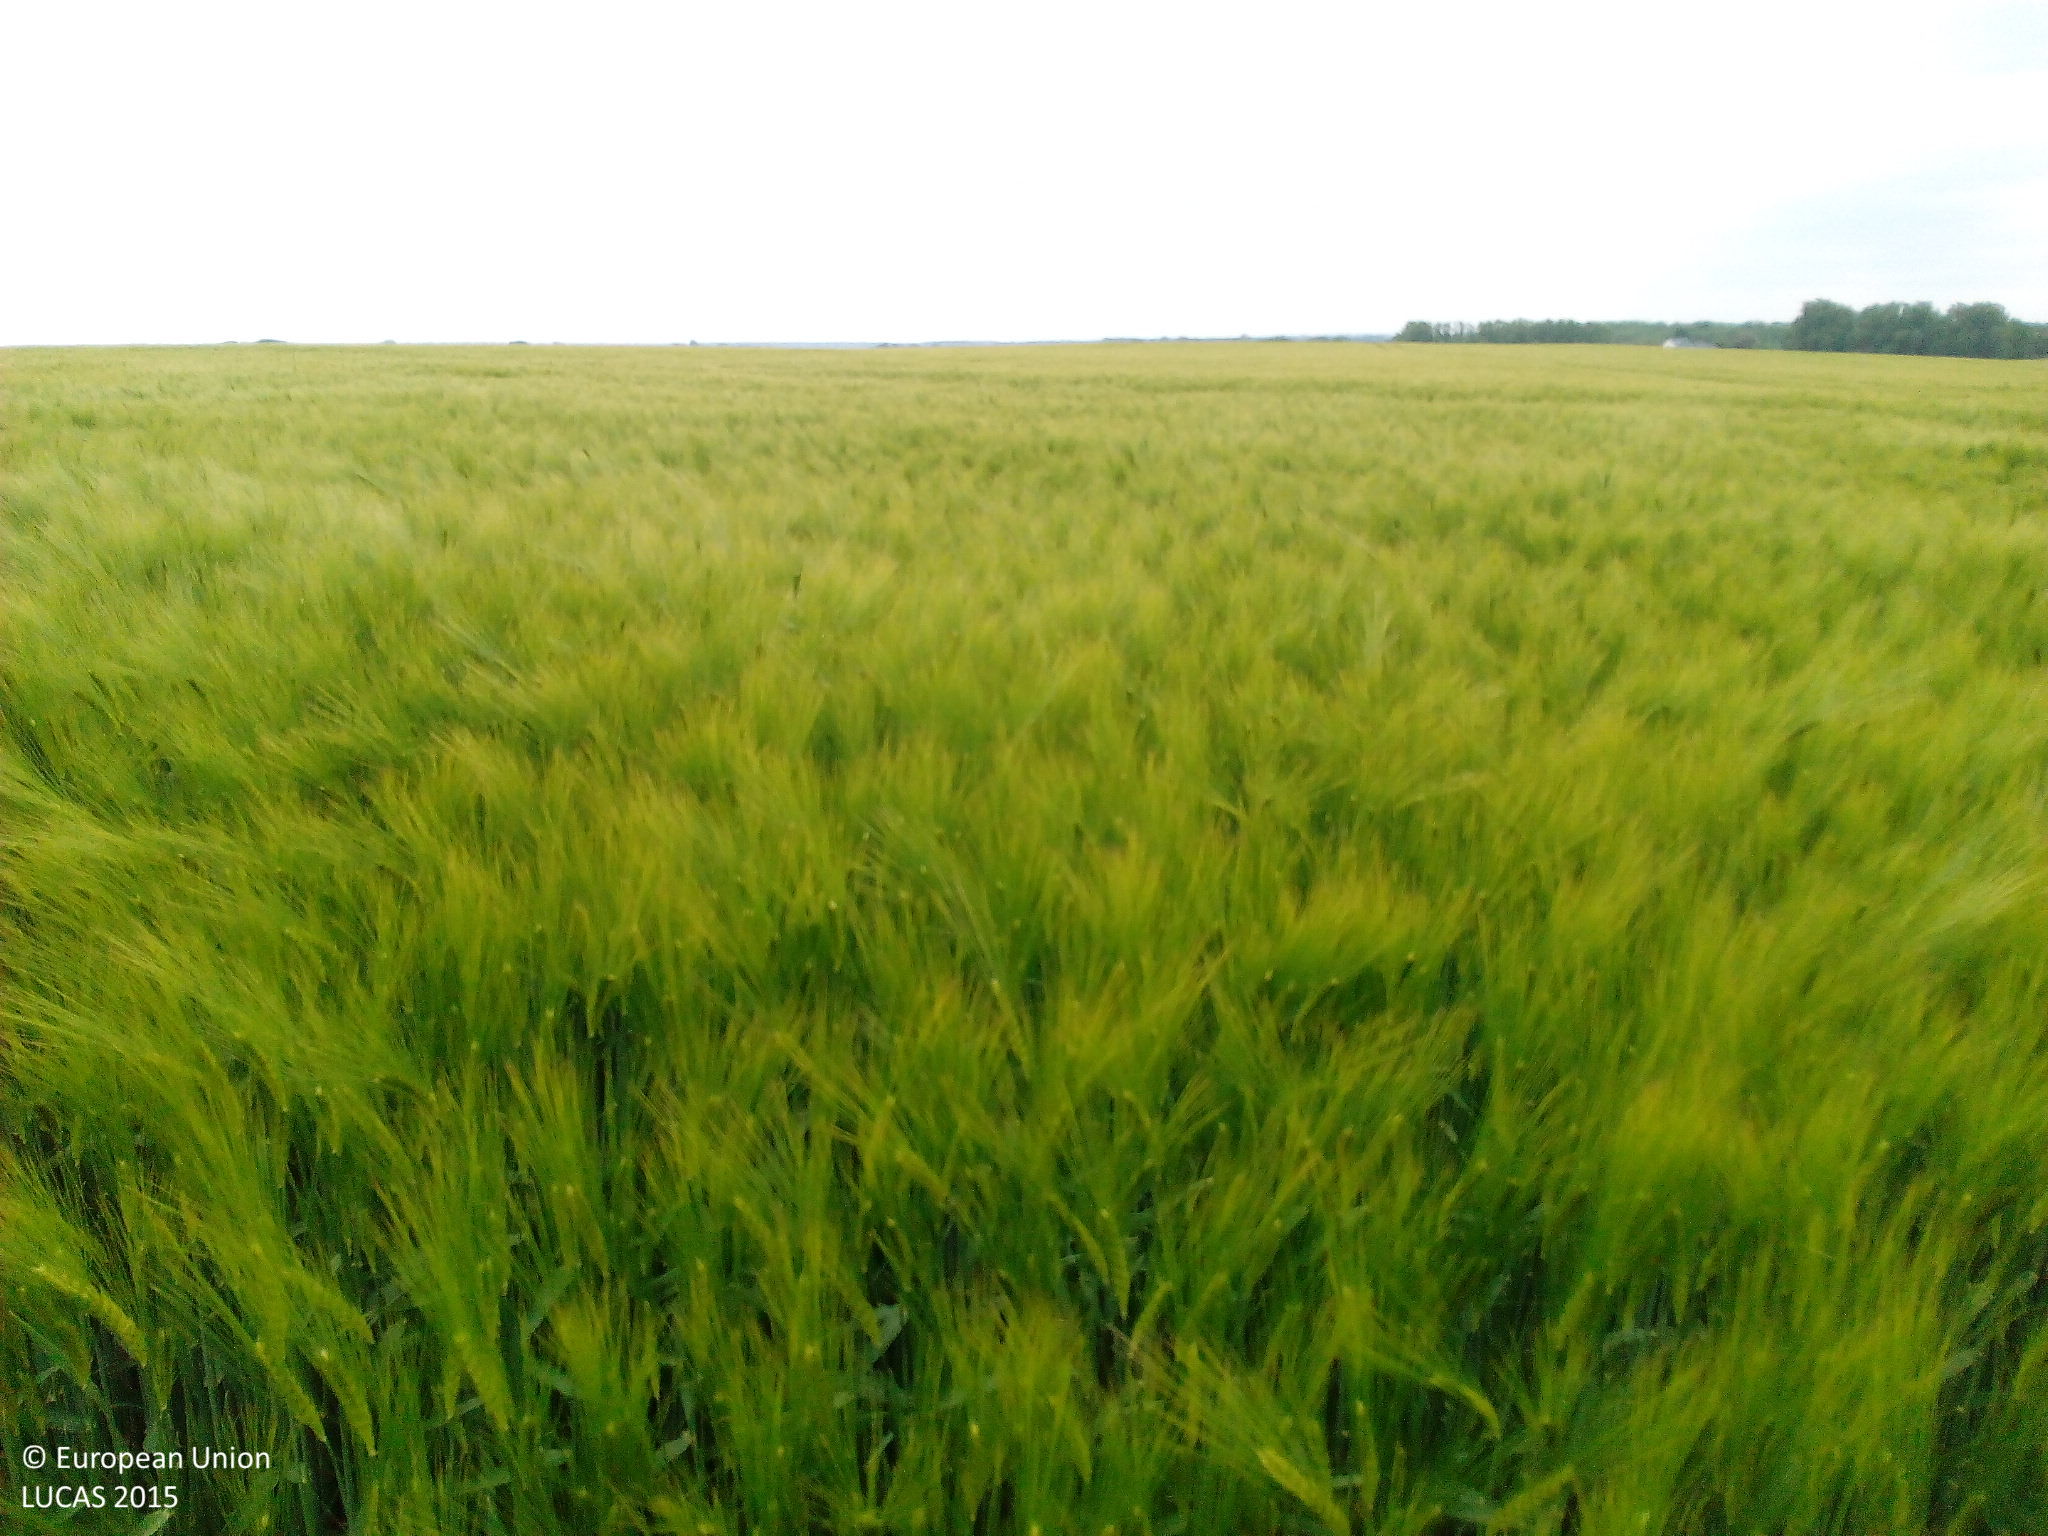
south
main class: Cropland
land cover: Barley
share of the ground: > 75 %
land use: Agriculture (excluding fallow land and kitchen gardens)
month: June
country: DE
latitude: 54.2923
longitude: 13.3024
